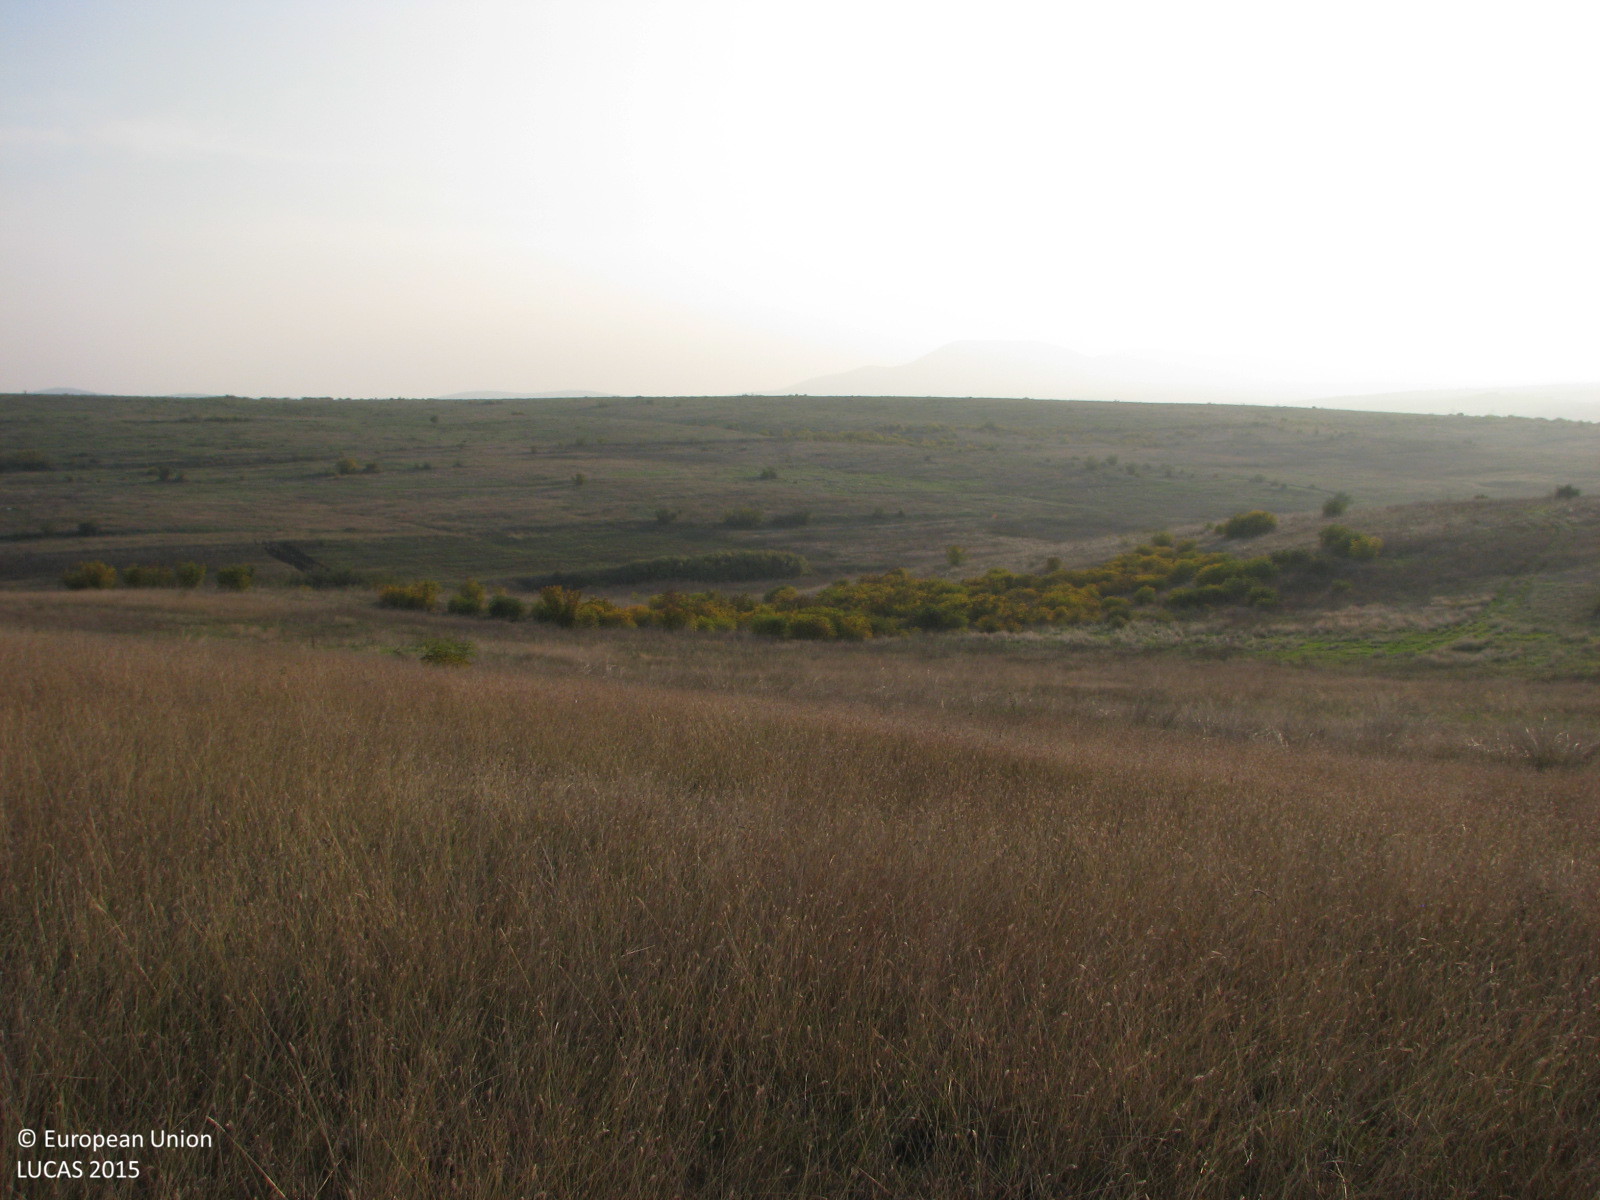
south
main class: Grassland
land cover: Grassland without tree/shrub cover
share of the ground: > 75 %
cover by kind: herbaceous plants 100 %
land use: Agriculture (excluding fallow land and kitchen gardens)
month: October
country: BG
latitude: 42.2954
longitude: 26.4257
